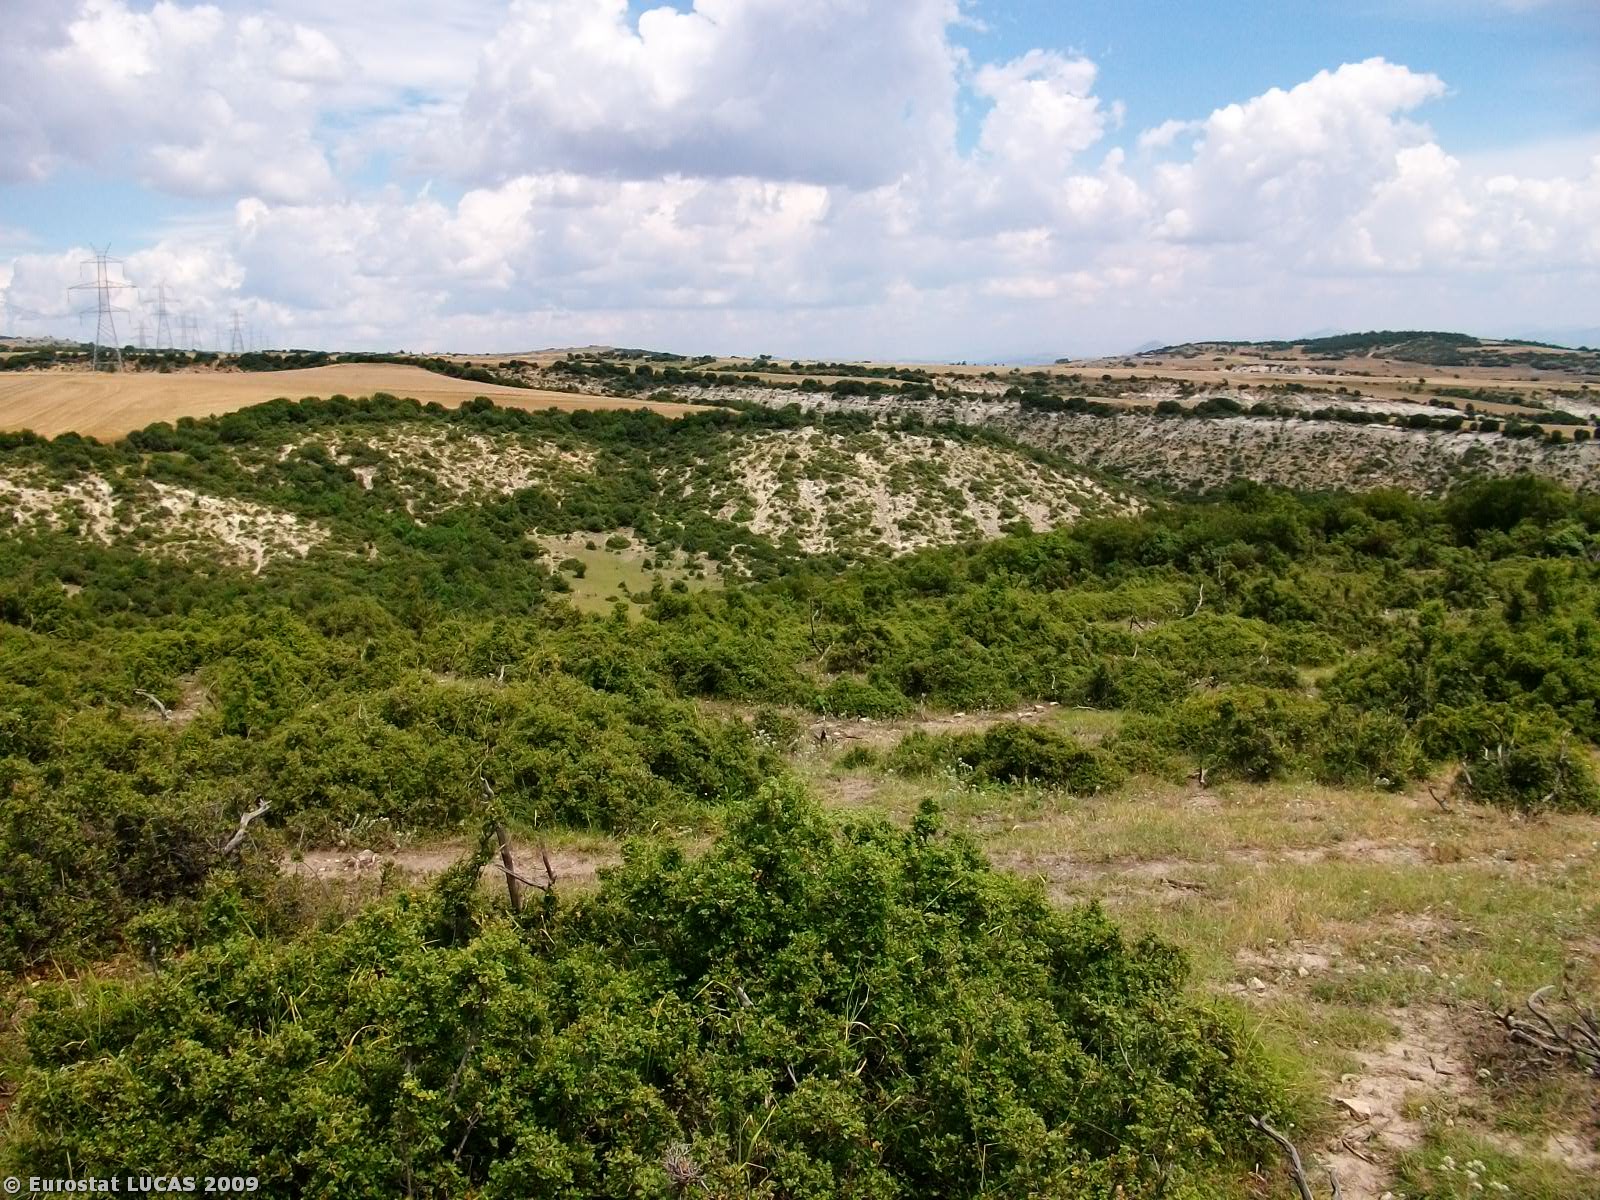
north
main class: Shrubland
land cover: Shrubland without tree cover
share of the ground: > 75 %
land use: Unused
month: July
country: GR
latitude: 40.1360
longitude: 21.8090
